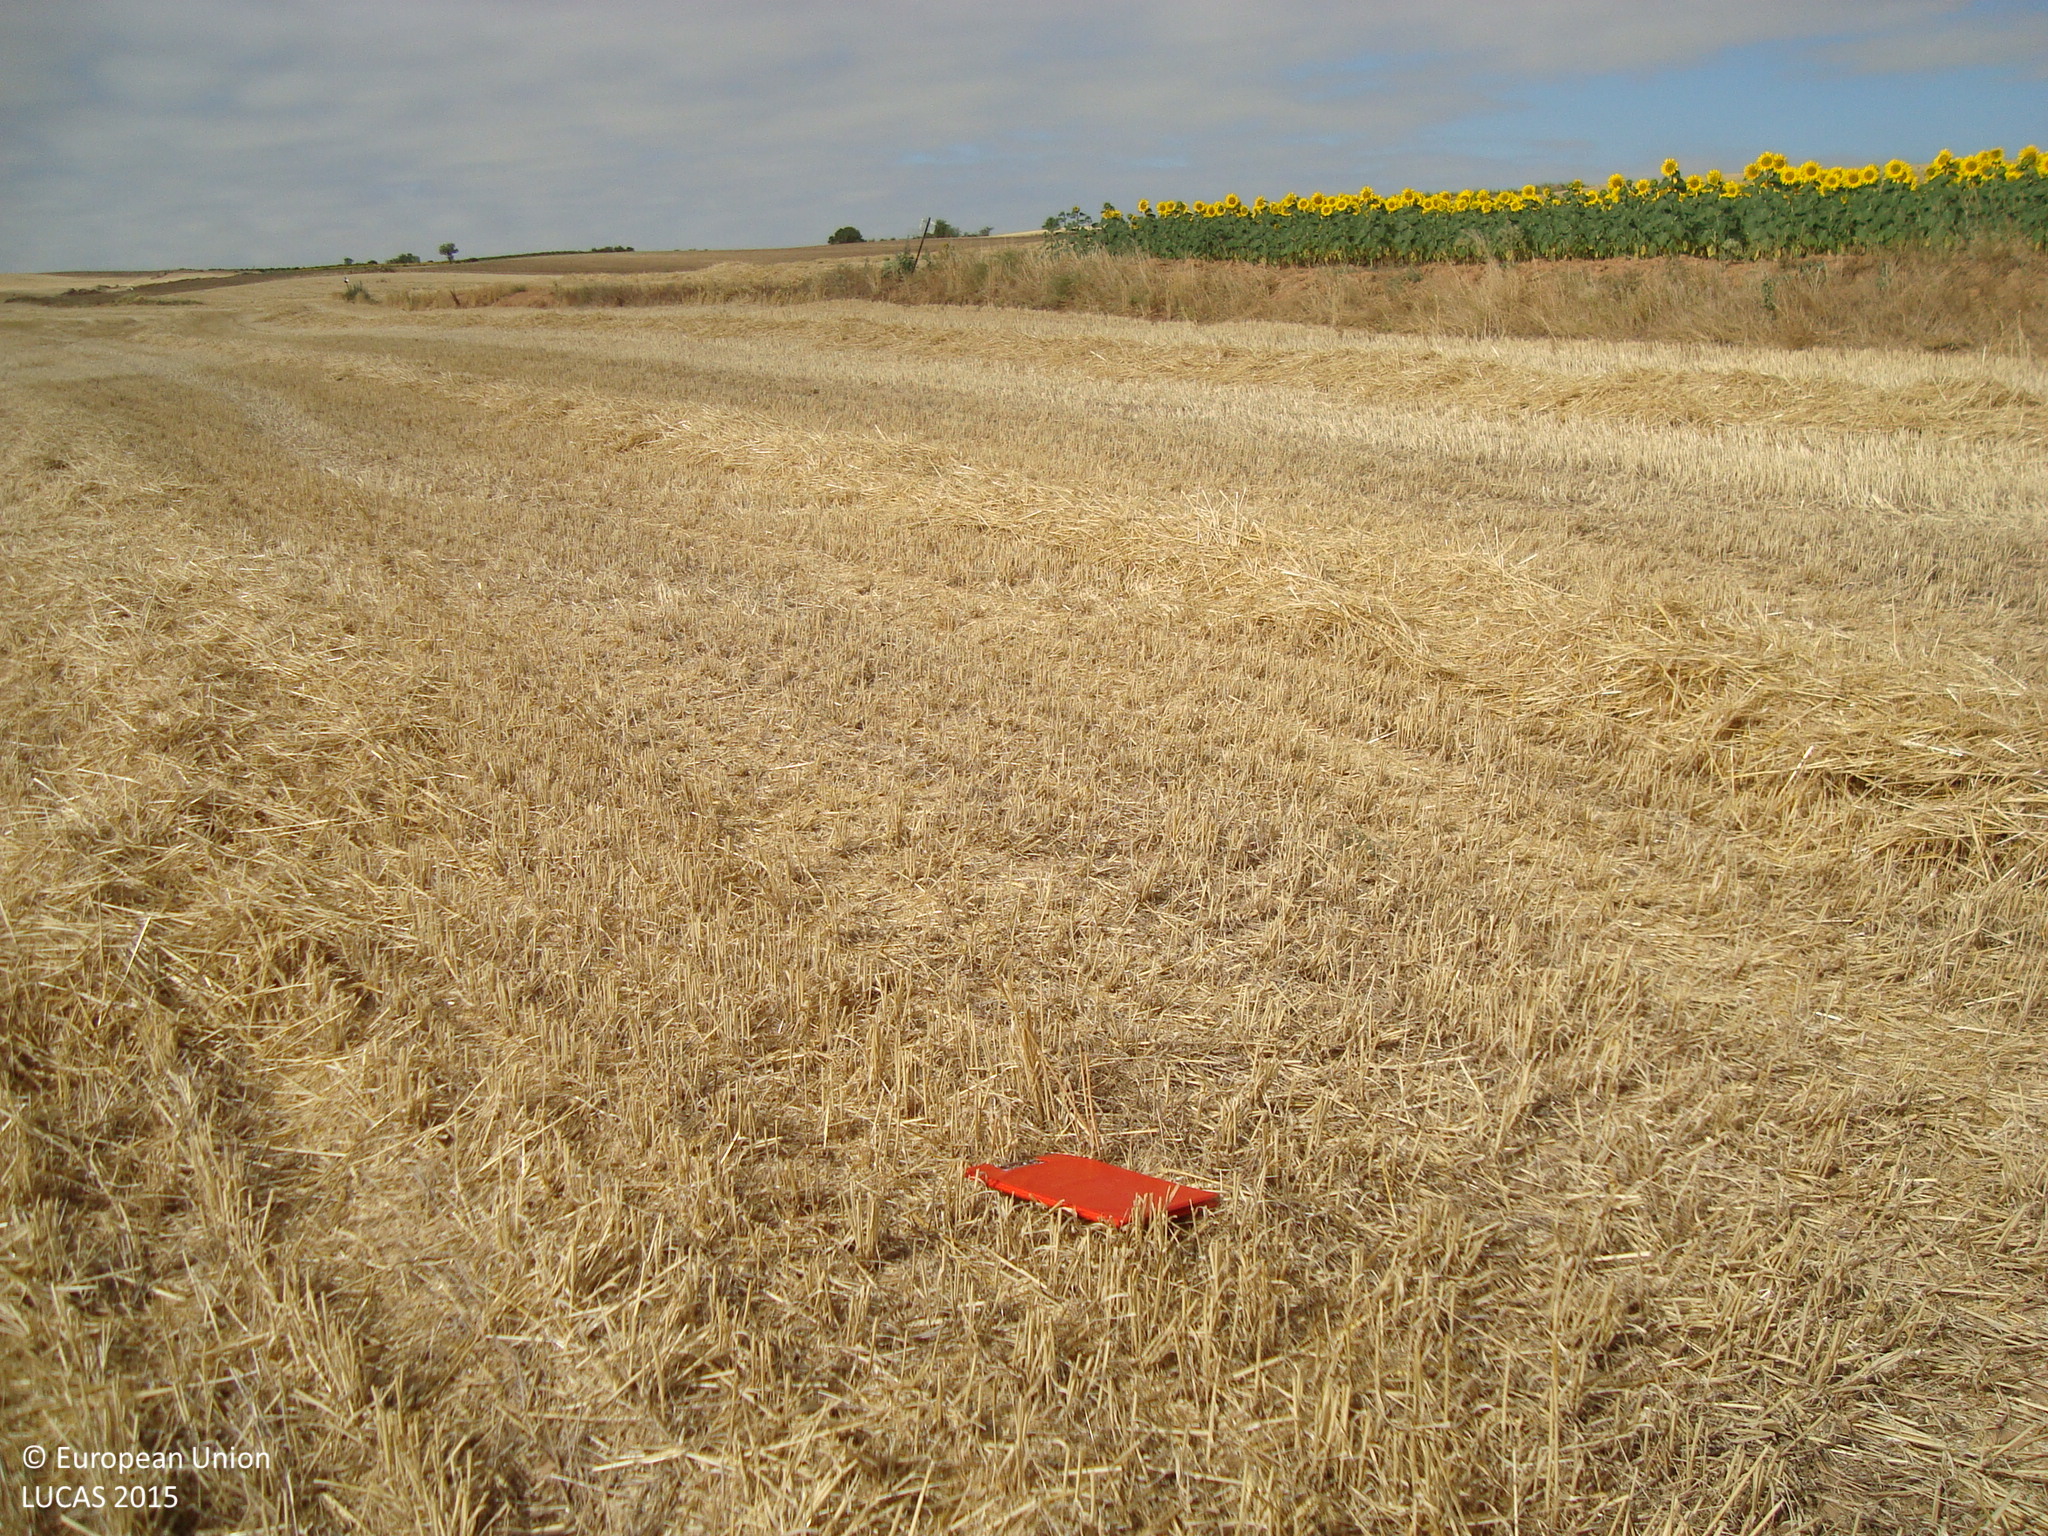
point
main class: Cropland
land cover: Common wheat
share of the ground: > 75 %
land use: Agriculture (excluding fallow land and kitchen gardens)
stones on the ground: < 10 %
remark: Harvested field
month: July
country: ES
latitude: 42.0004
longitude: -3.9074
